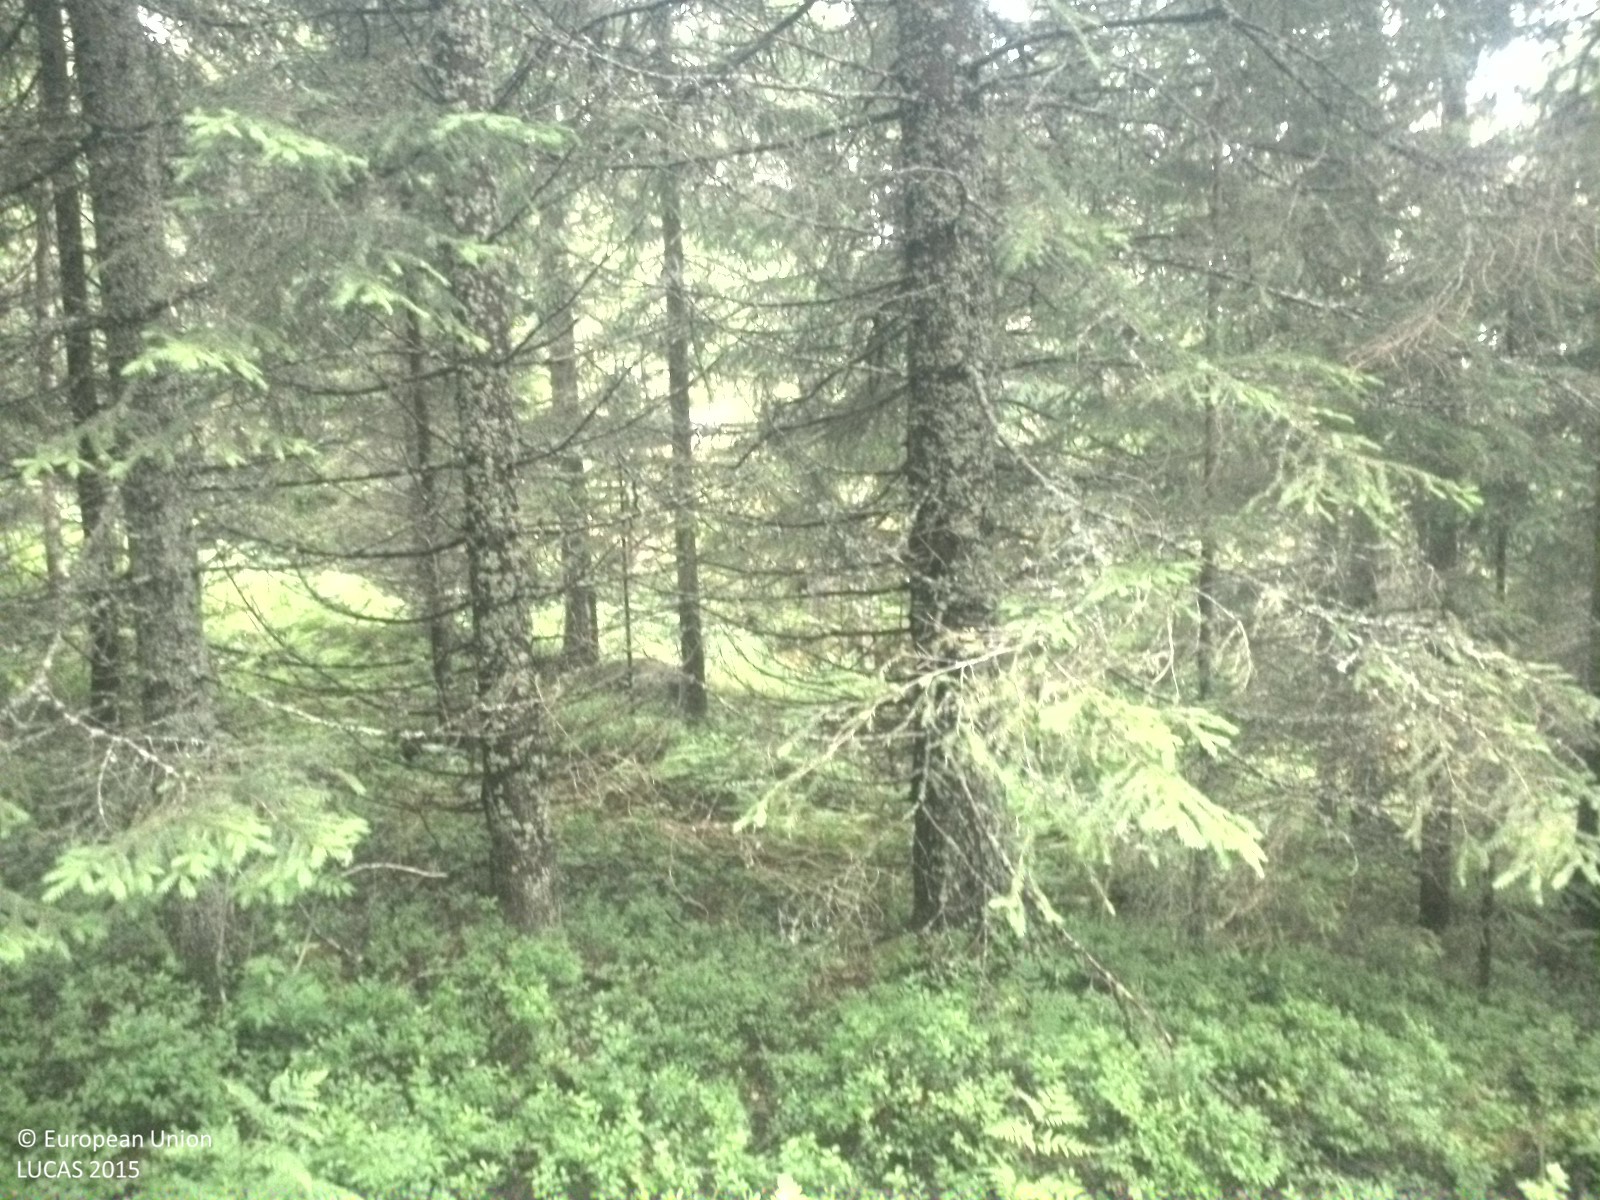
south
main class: Woodland
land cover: Spruce dominated mixed woodland
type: boreal forest
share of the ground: 50 - 75 %
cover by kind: coniferous forest trees 45 %, broadleaved forest trees 25 %, herbaceous plants 15 %, lichens and mosses 10 %, shrubs 5 %
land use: Forestry
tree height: > 5 m
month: July
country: SE
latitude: 62.5491
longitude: 17.1933
